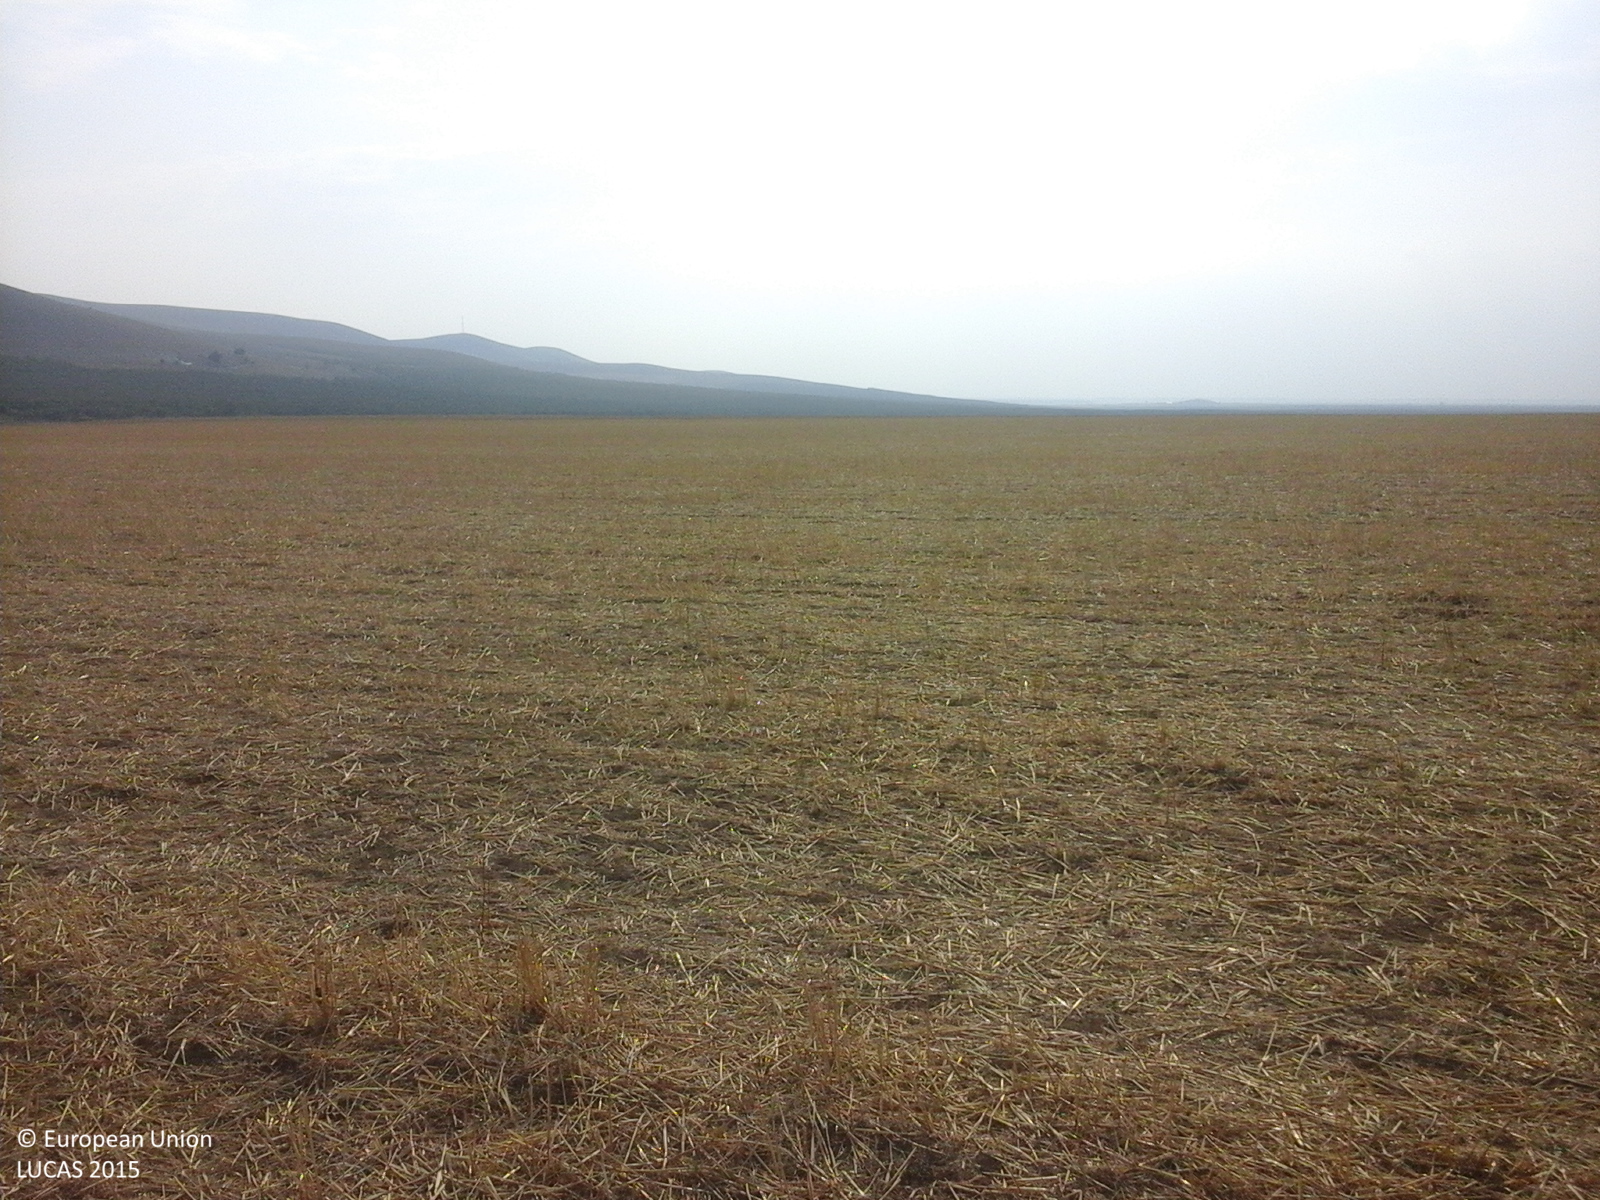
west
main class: Cropland
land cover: Common wheat
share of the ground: 50 - 75 %
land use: Agriculture (excluding fallow land and kitchen gardens)
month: July
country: RO
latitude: 45.0252
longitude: 28.3360
